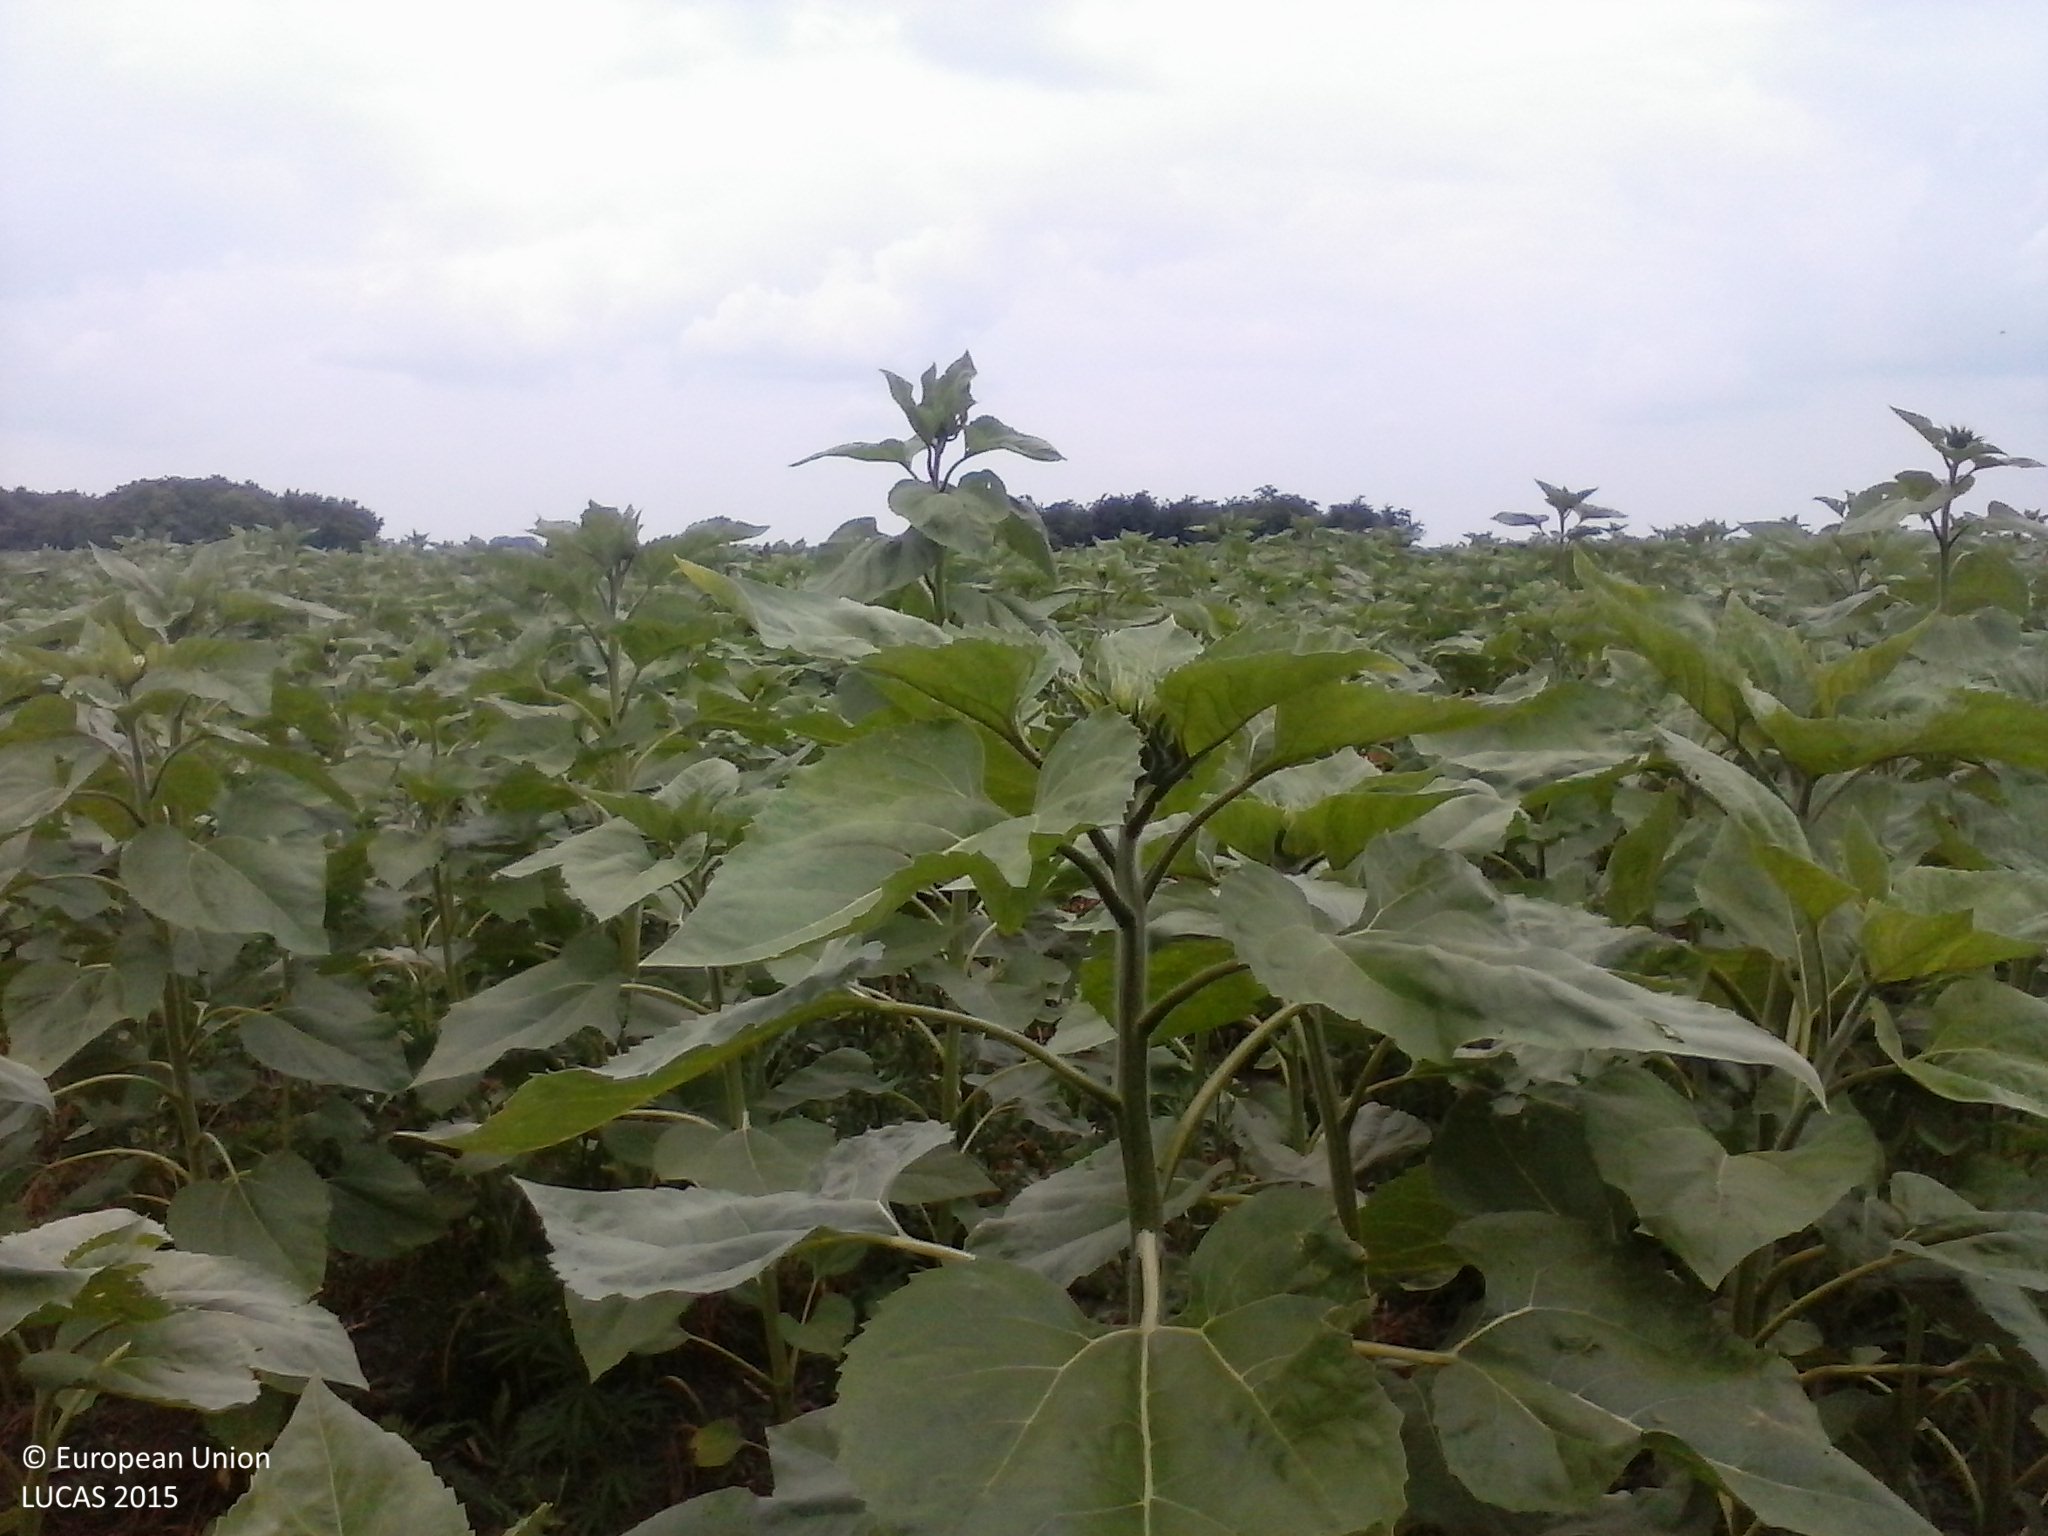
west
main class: Cropland
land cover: Sunflower
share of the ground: > 75 %
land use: Agriculture (excluding fallow land and kitchen gardens)
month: June
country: HU
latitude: 46.2494
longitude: 19.5503
